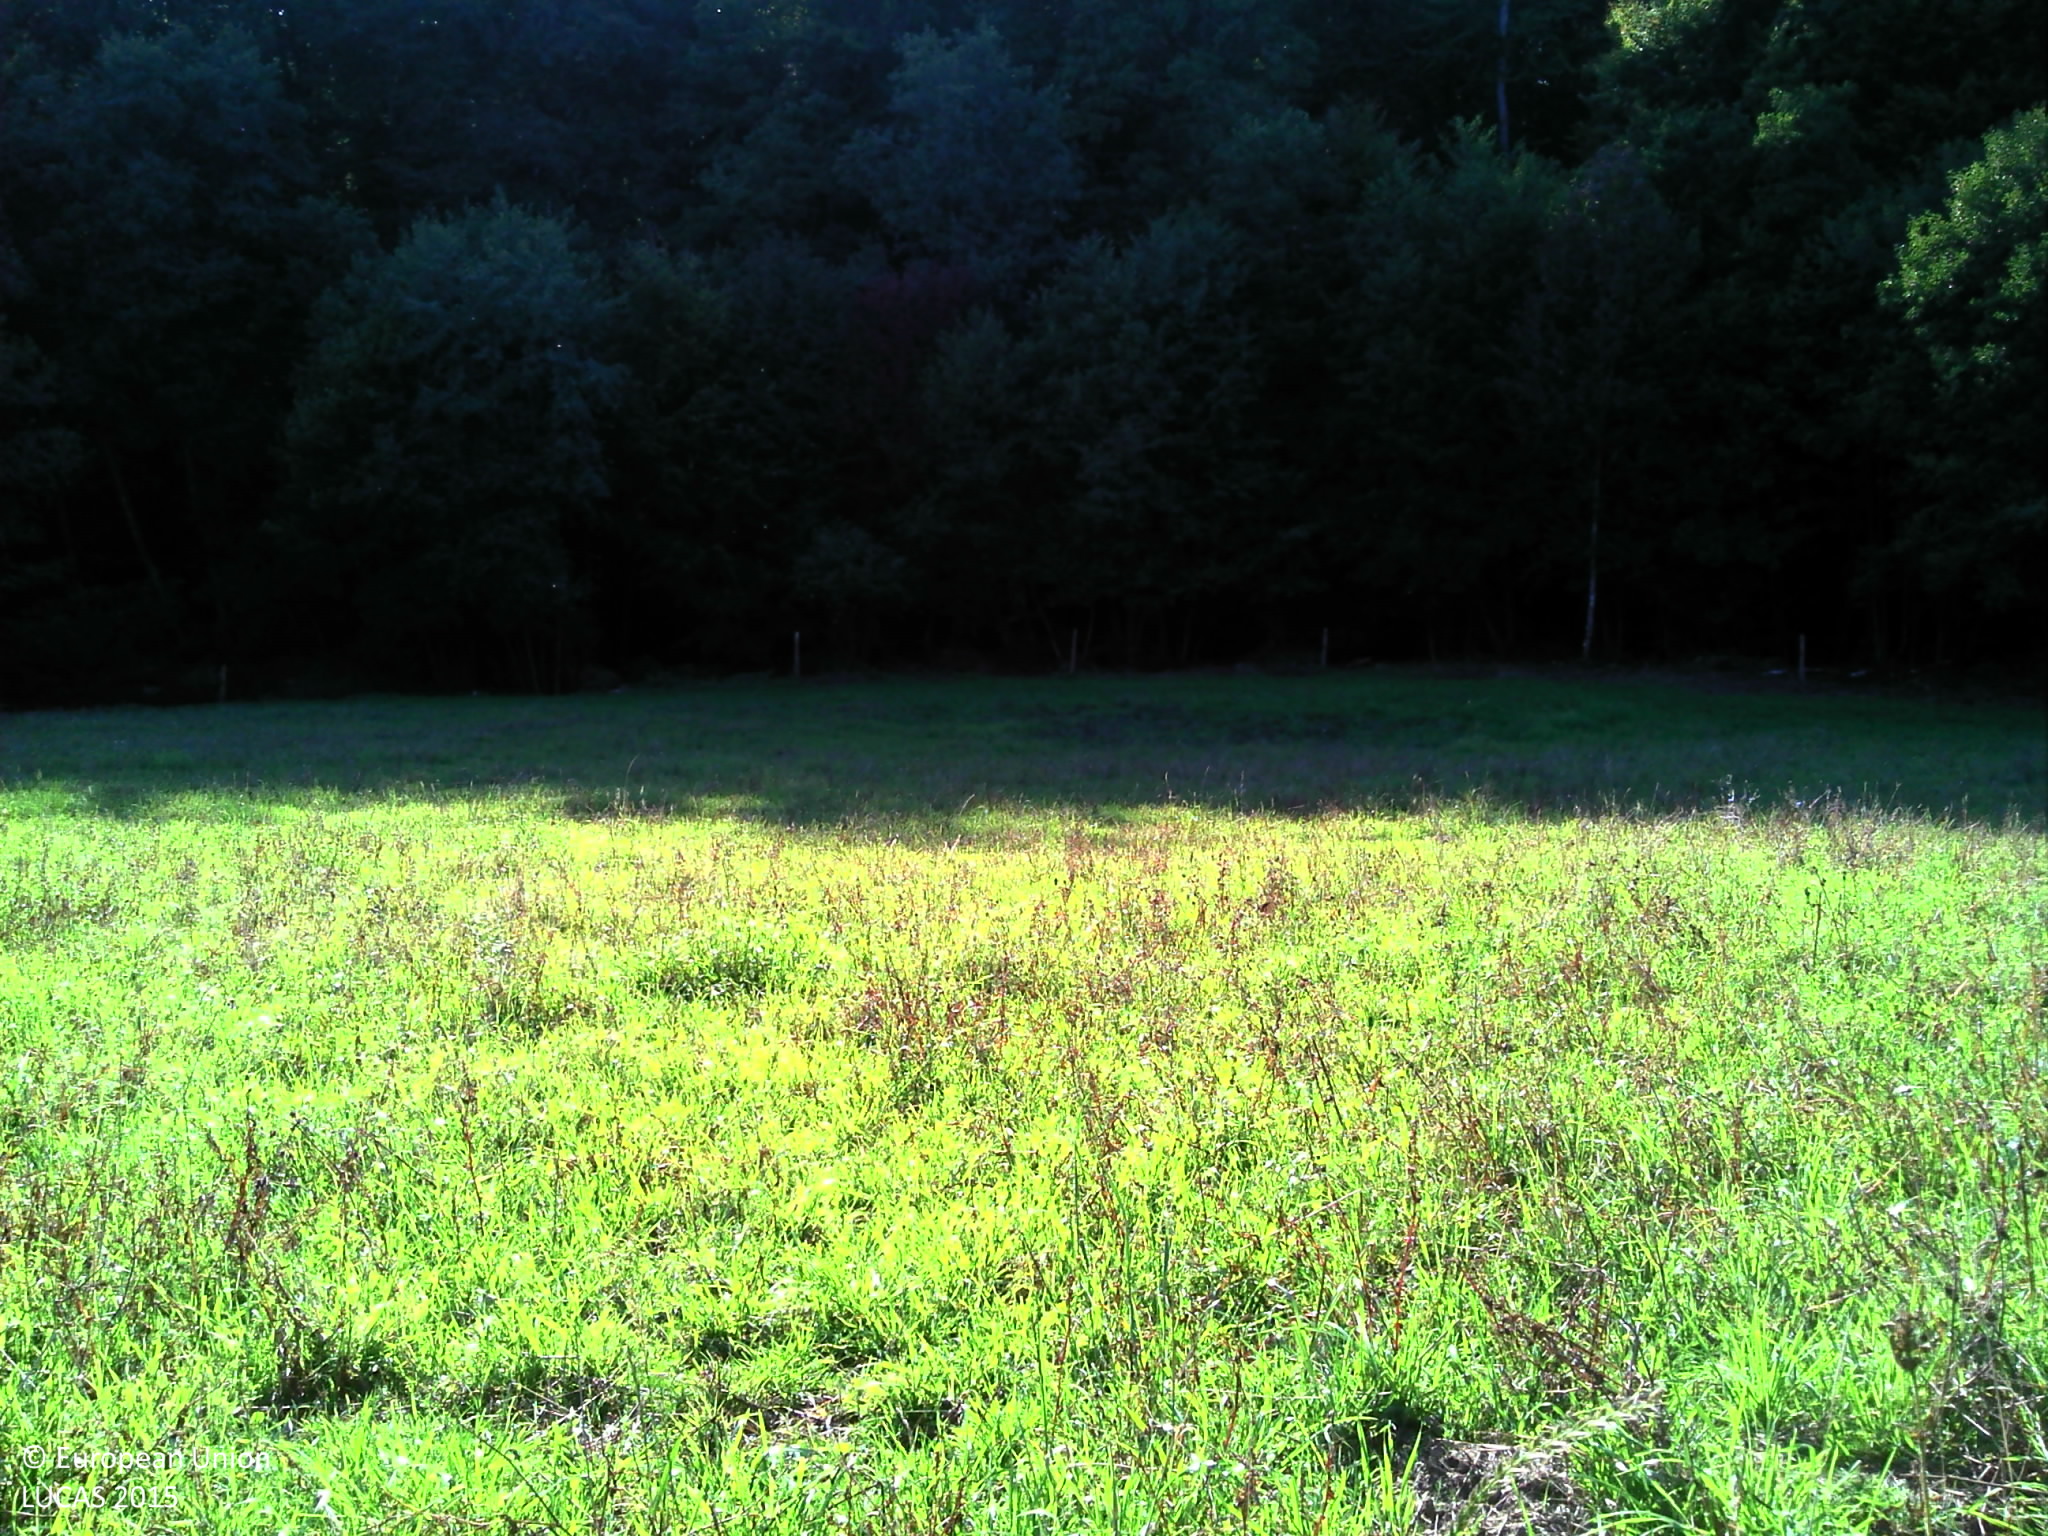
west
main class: Grassland
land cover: Grassland without tree/shrub cover
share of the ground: > 75 %
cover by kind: herbaceous plants 100 %
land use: Agriculture (excluding fallow land and kitchen gardens)
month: September
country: FR
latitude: 45.8014
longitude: 2.8063
